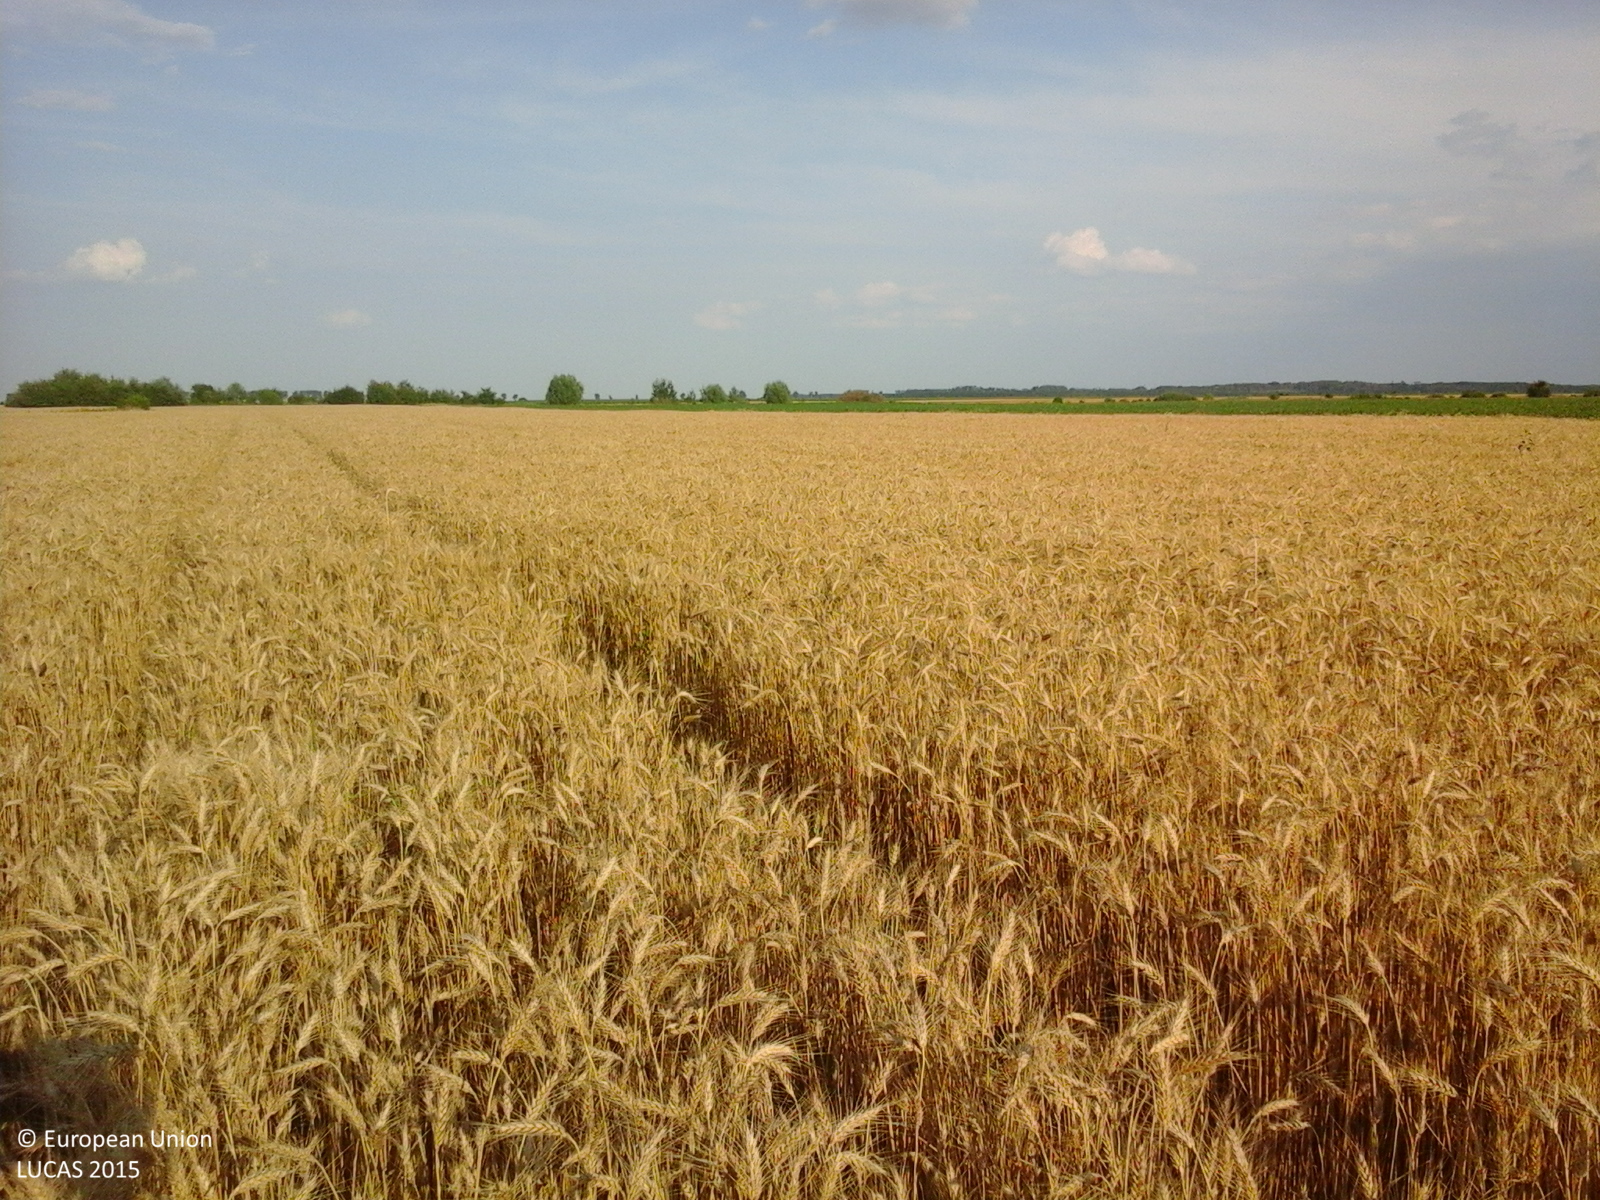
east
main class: Cropland
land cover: Common wheat
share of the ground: > 75 %
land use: Agriculture (excluding fallow land and kitchen gardens)
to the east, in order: Common wheat
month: June
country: RO
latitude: 44.5671
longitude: 26.2394
